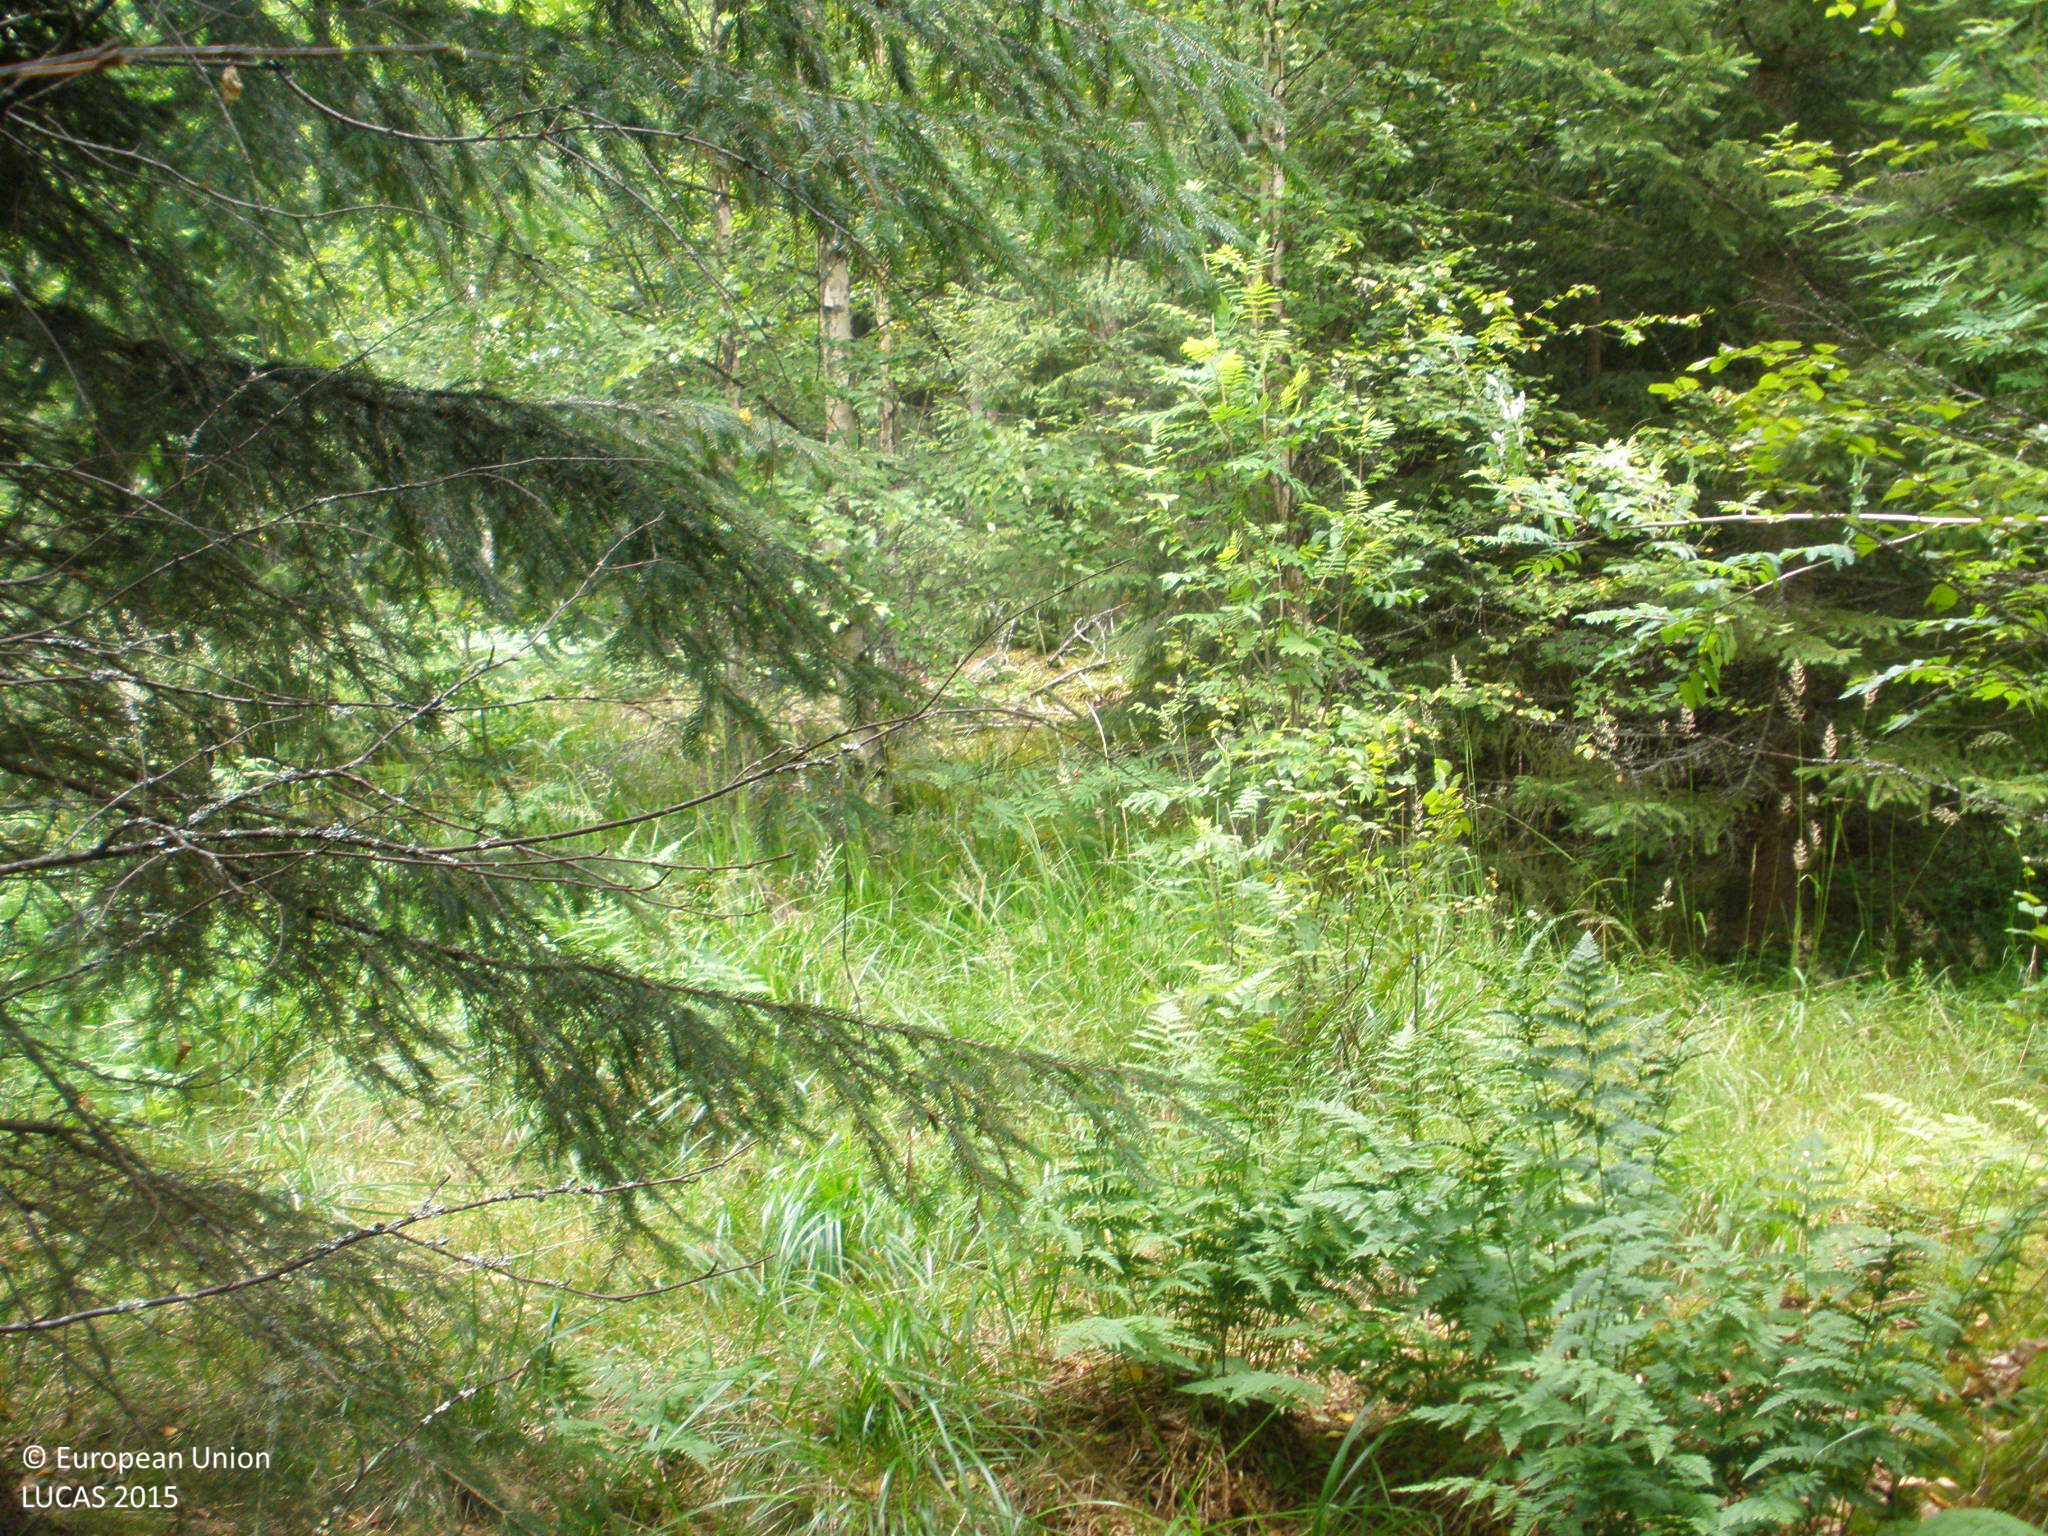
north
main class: Woodland
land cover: Spruce dominated mixed woodland
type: boreal forest
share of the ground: > 75 %
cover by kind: broadleaved forest trees 45 %, coniferous forest trees 30 %, herbaceous plants 15 %, shrubs 10 %
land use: Forestry
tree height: > 5 m
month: July
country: FI
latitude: 61.1479
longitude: 25.0686
